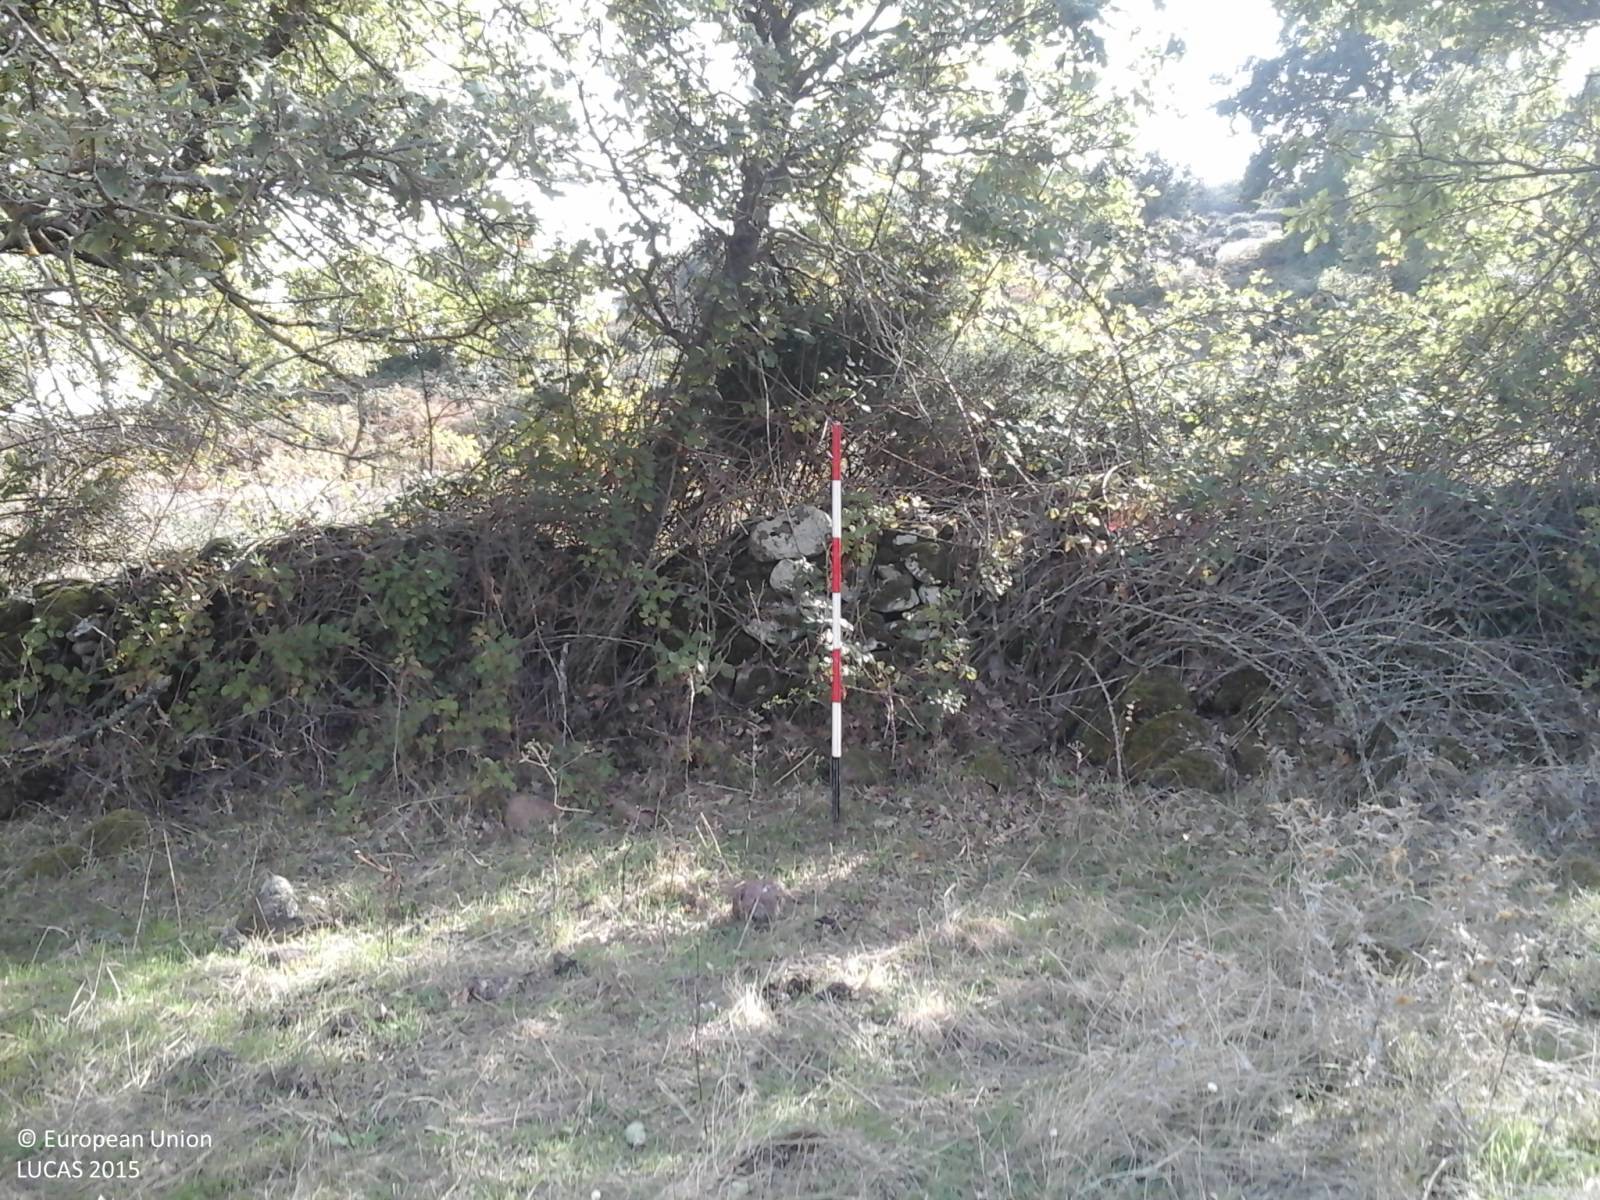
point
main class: Grassland
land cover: Grassland without tree/shrub cover
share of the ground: 25 - 50 %
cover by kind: herbaceous plants 100 %
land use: Agriculture (excluding fallow land and kitchen gardens)
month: October
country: IT
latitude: 40.2964
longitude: 8.8180
